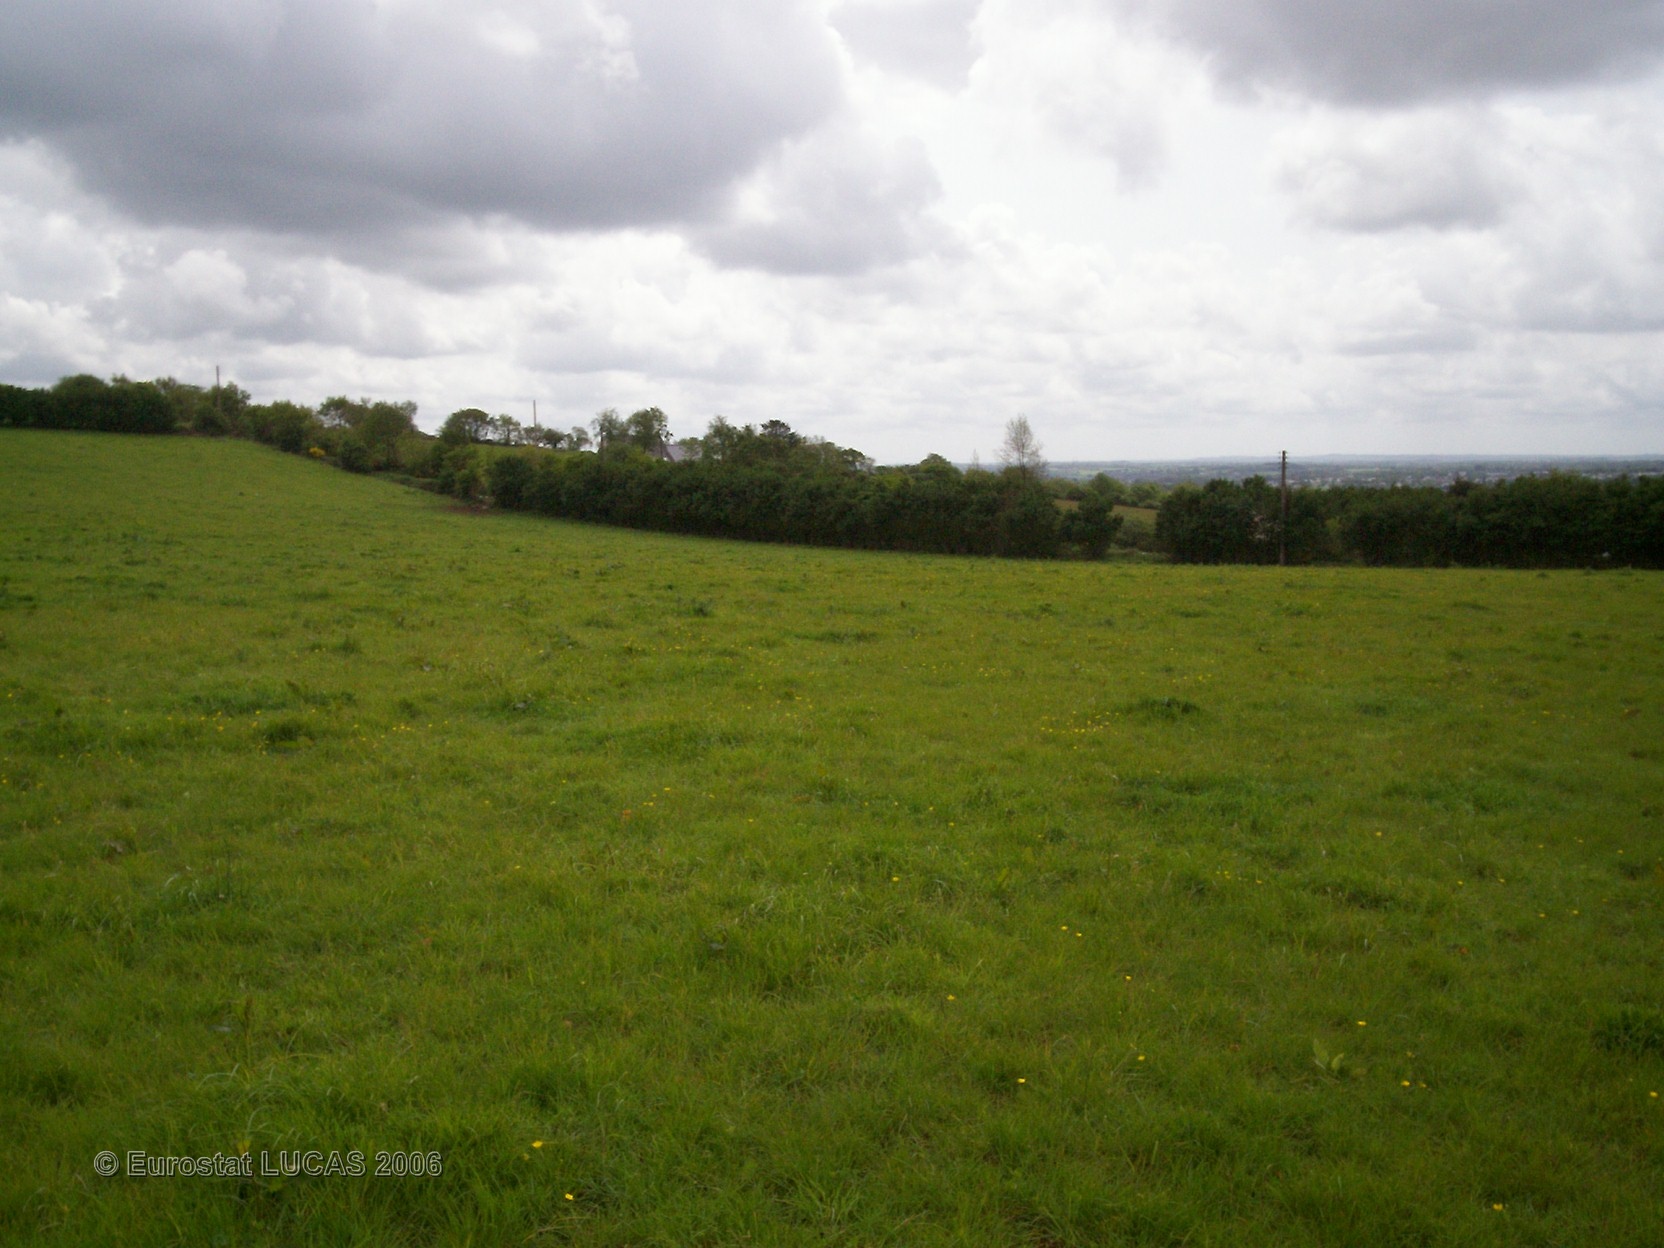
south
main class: Grassland
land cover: Grassland without tree/shrub cover
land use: Agriculture (excluding fallow land and kitchen gardens)
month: May
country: FR
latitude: 48.1181
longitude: -3.9352
